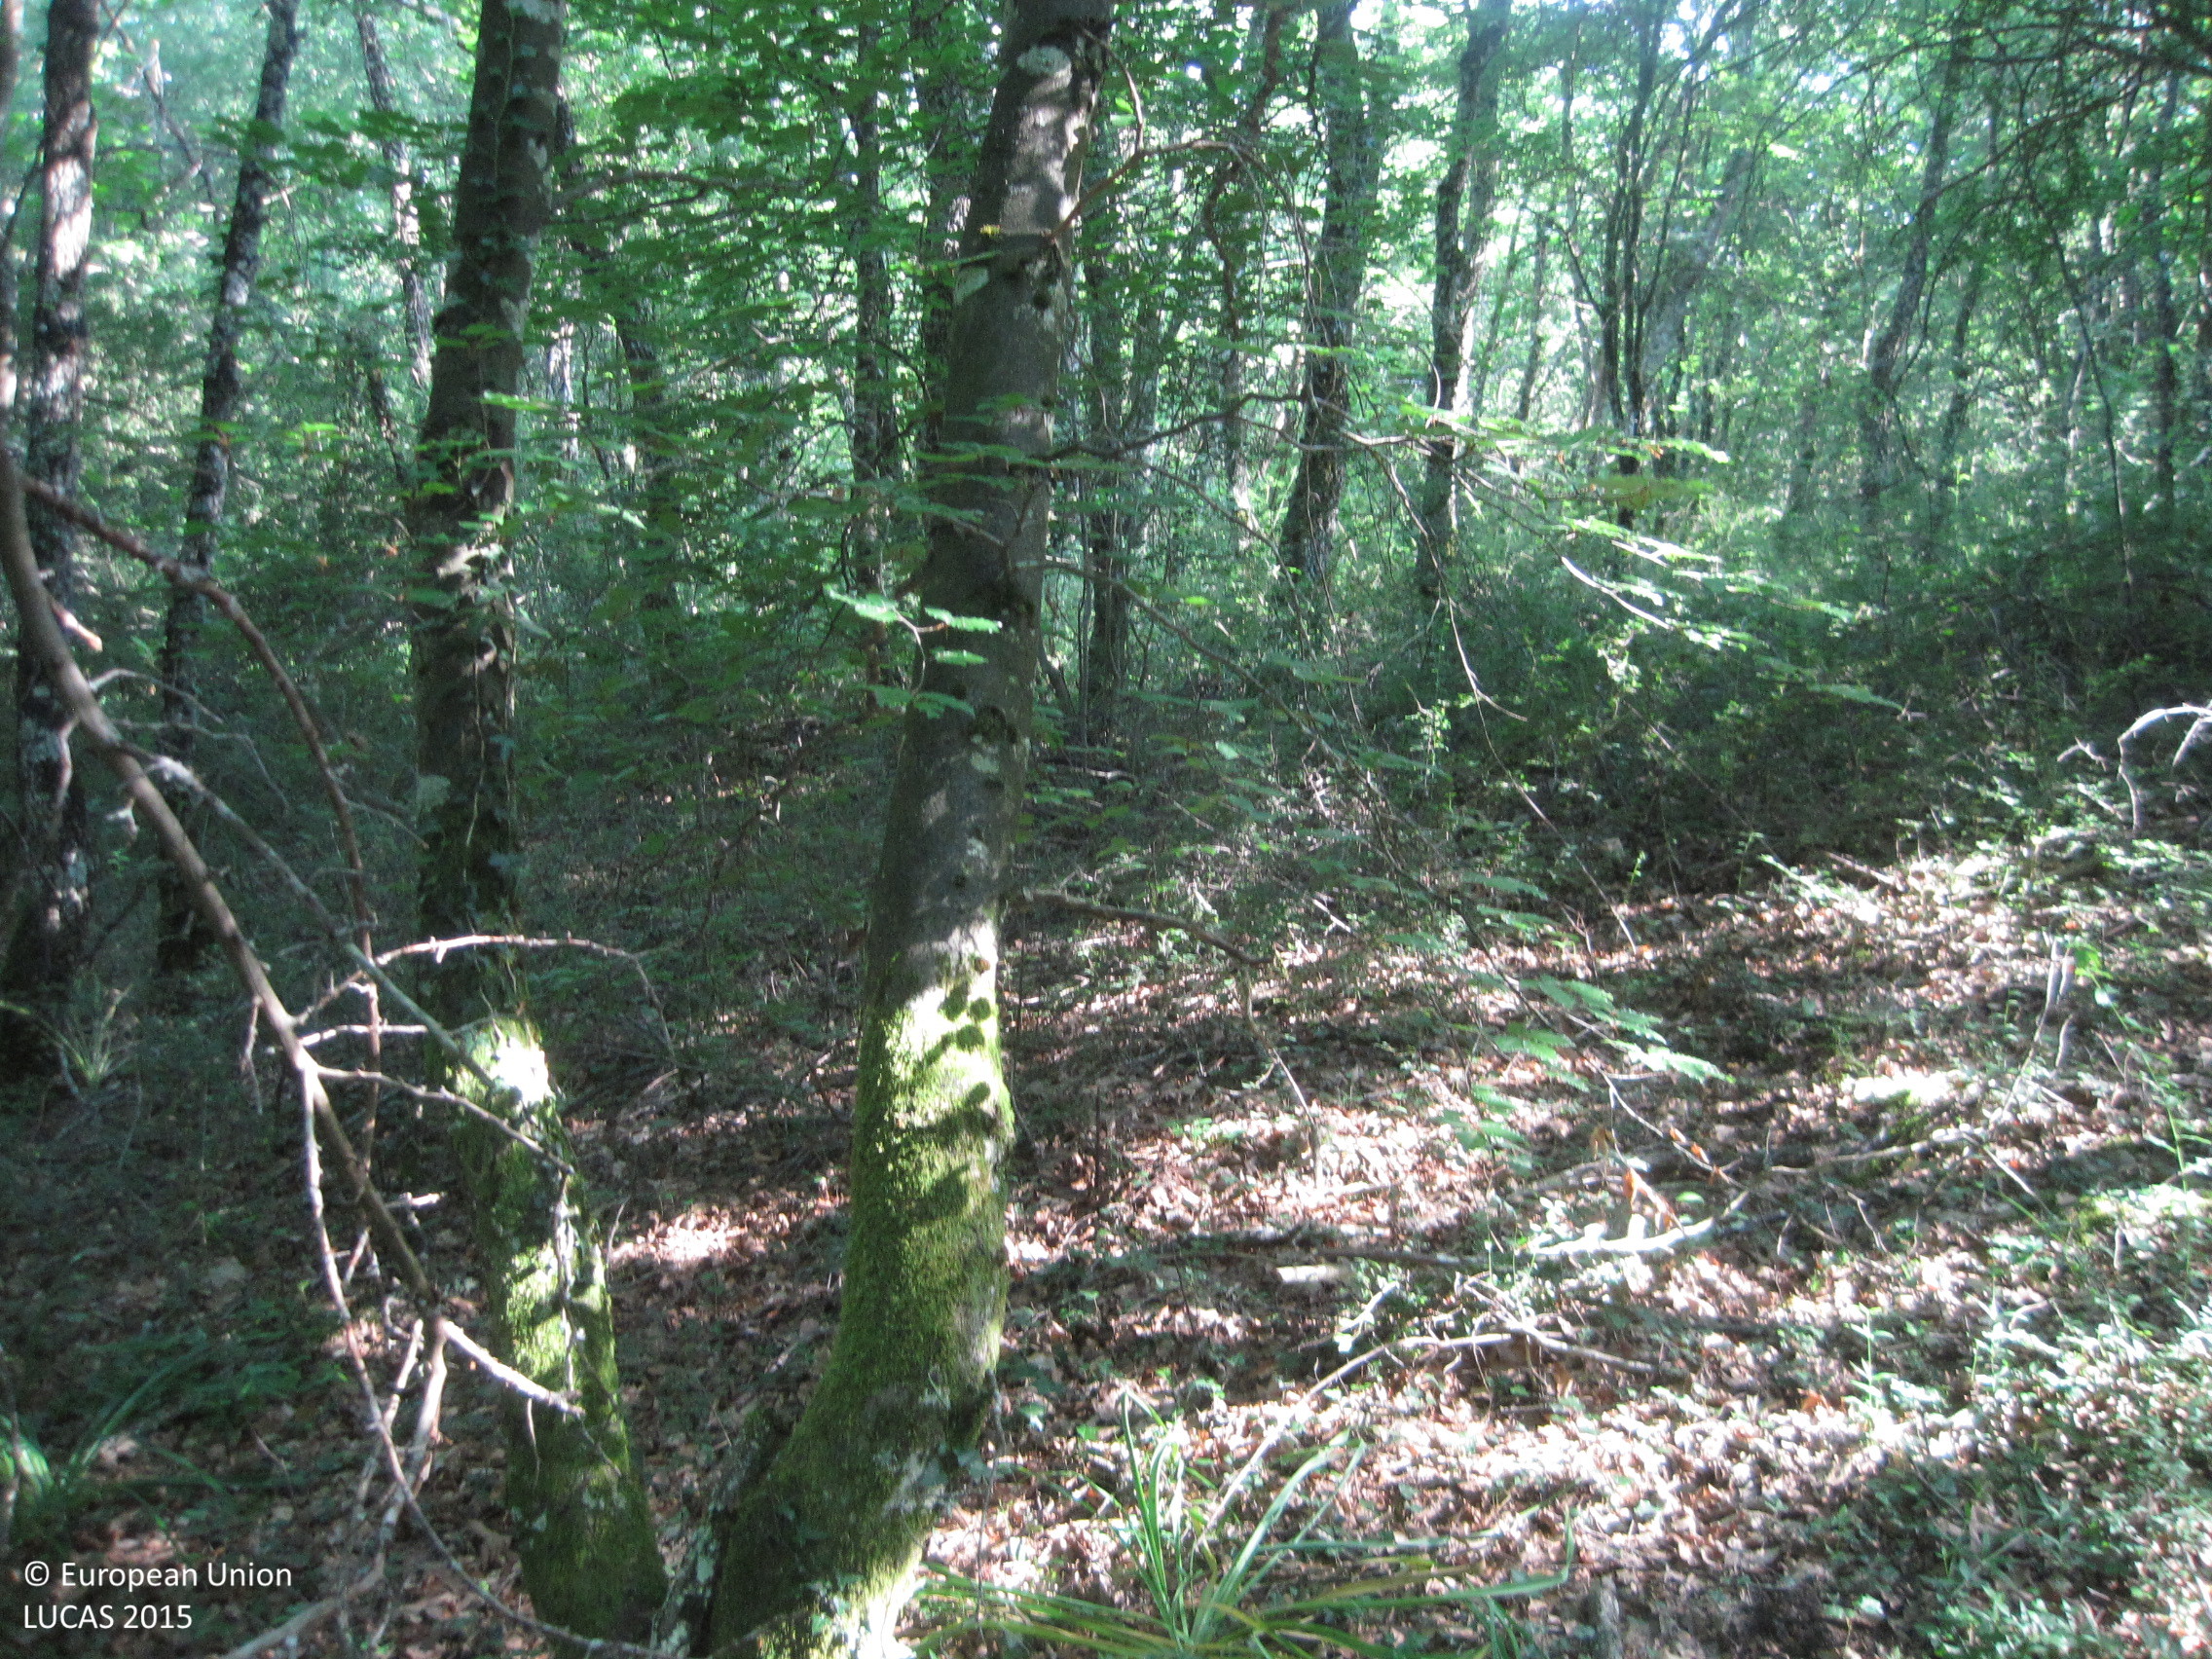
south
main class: Woodland
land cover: Broadleaved woodland
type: beech forest
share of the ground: > 75 %
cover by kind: broadleaved forest trees 100 %
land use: Forestry
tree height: > 5 m
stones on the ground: < 10 %
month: June
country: ES
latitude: 42.9522
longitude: -1.7470
